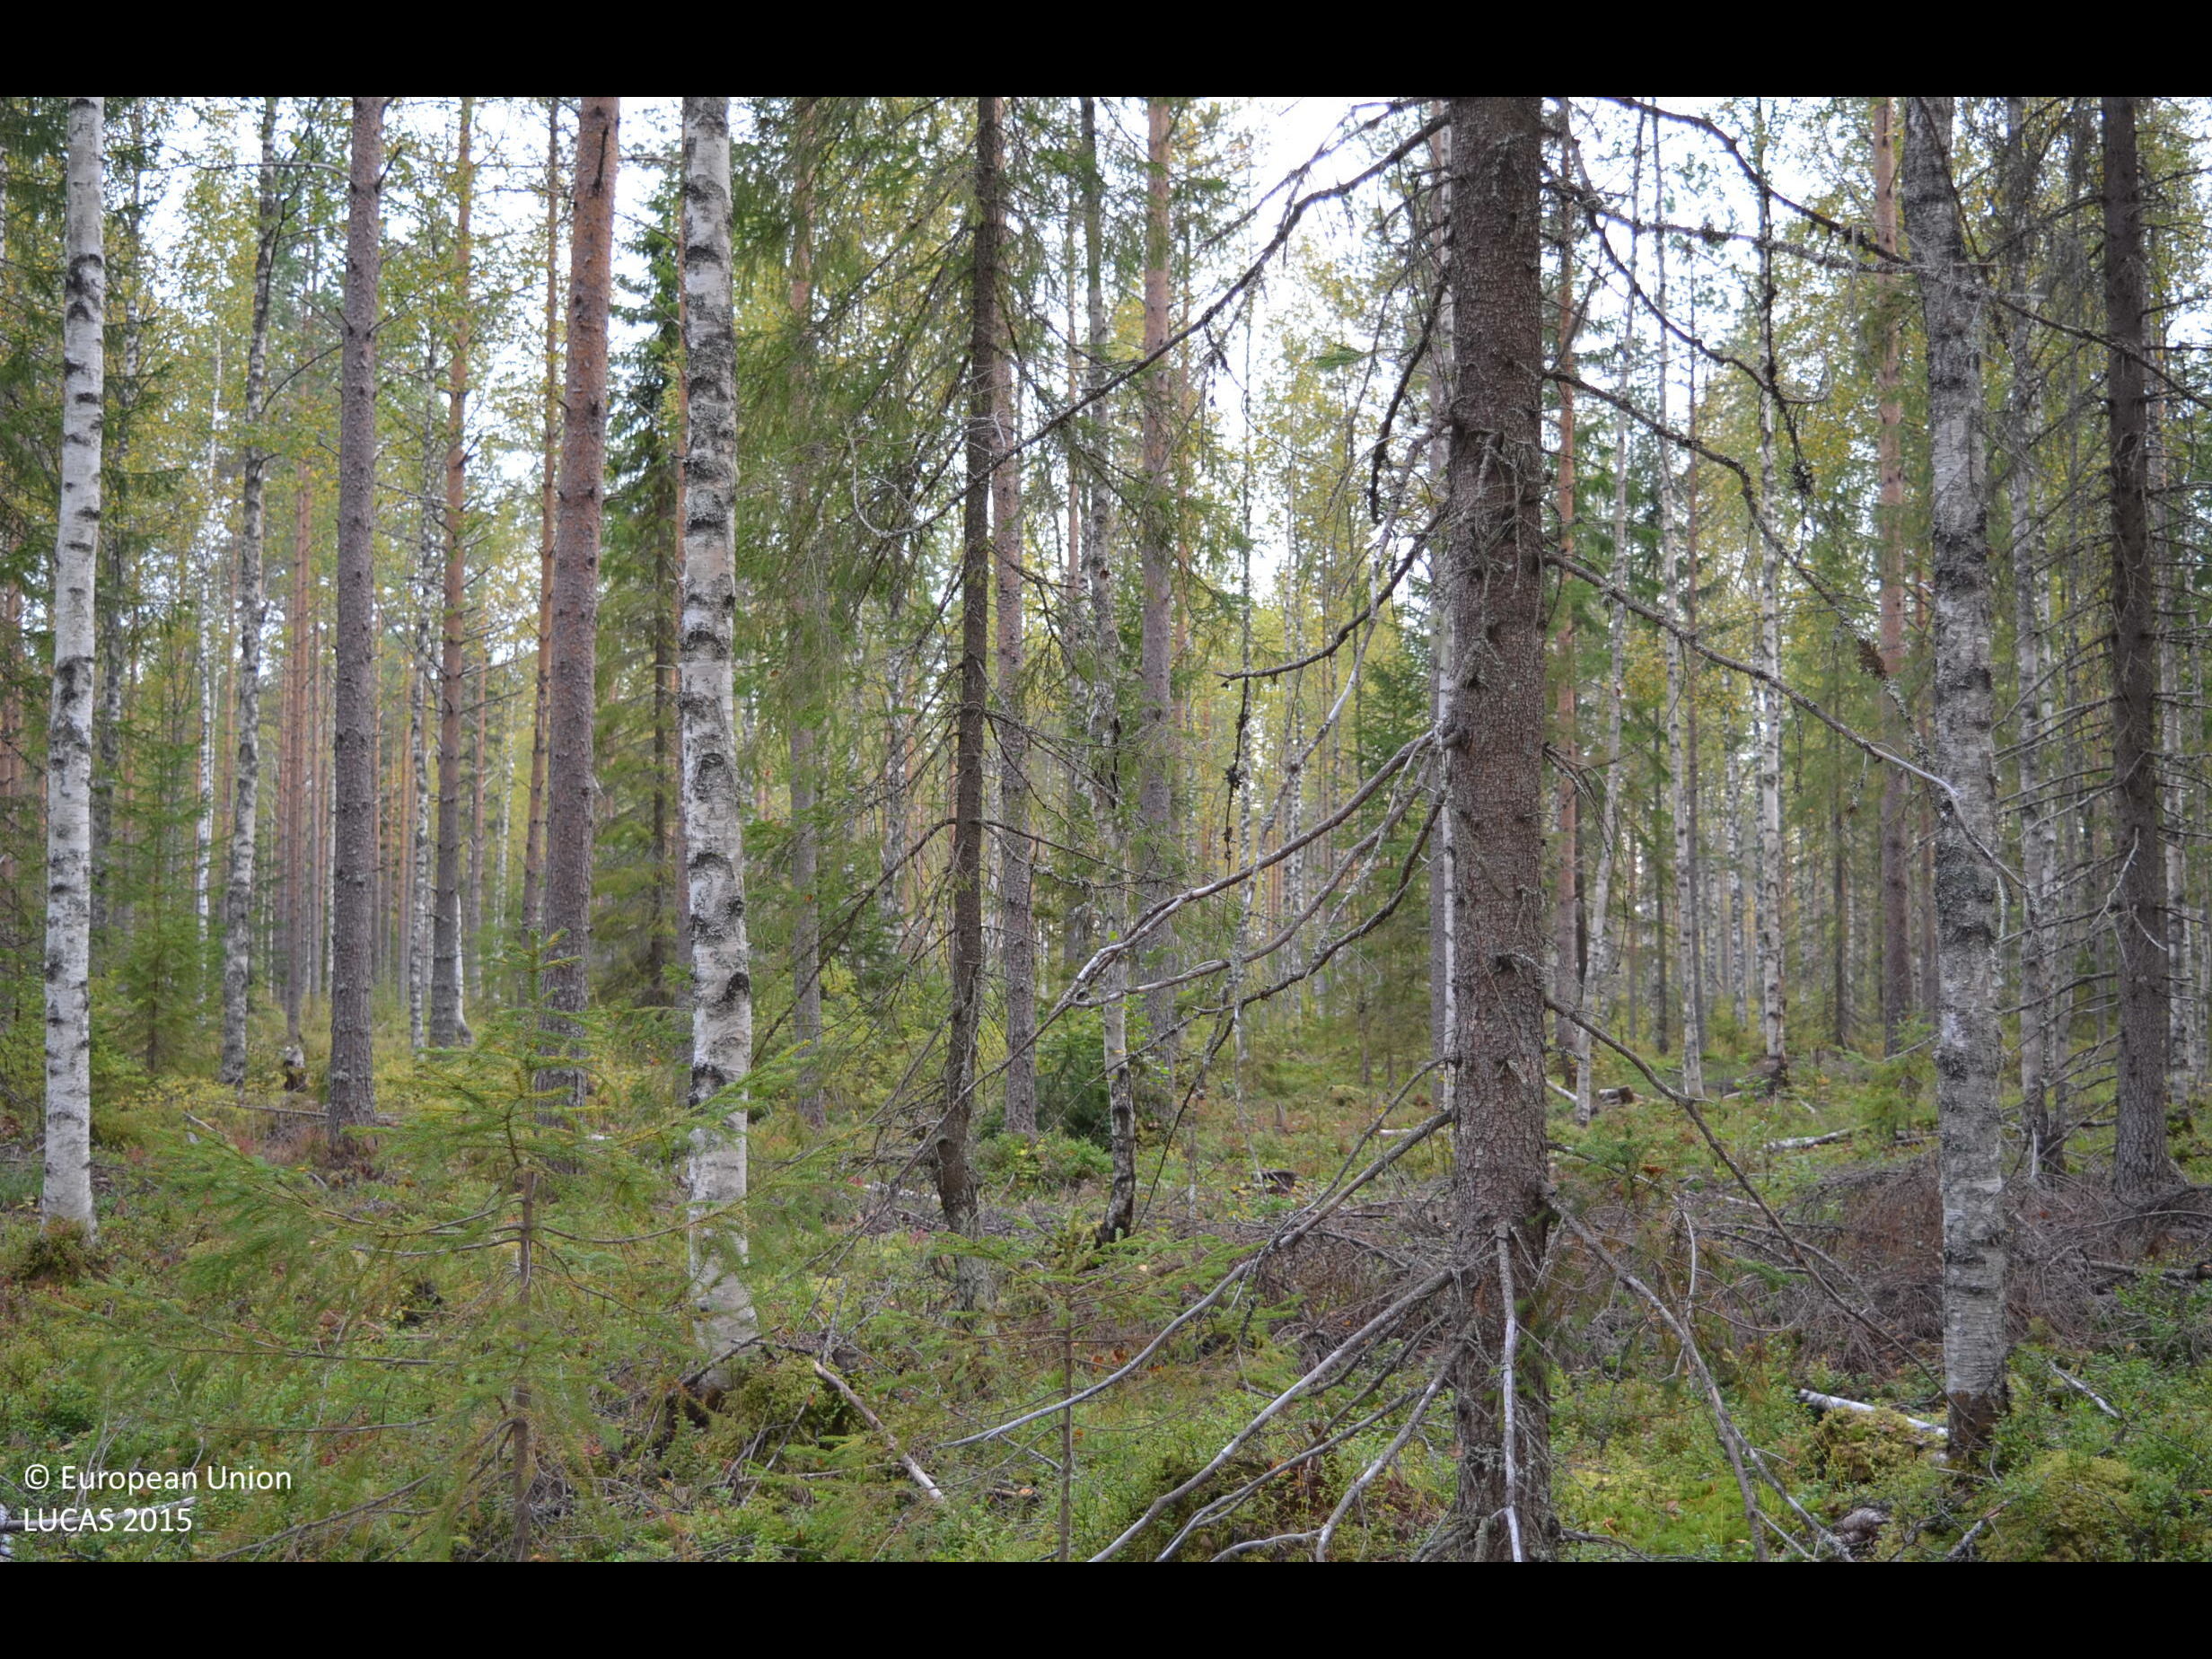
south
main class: Woodland
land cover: Other mixed woodland
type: boreal forest
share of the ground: 50 - 75 %
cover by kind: coniferous forest trees 40 %, broadleaved forest trees 30 %, shrubs 20 %, lichens and mosses 10 %
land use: Forestry
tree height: > 5 m
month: September
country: FI
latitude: 62.8627
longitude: 24.4906
